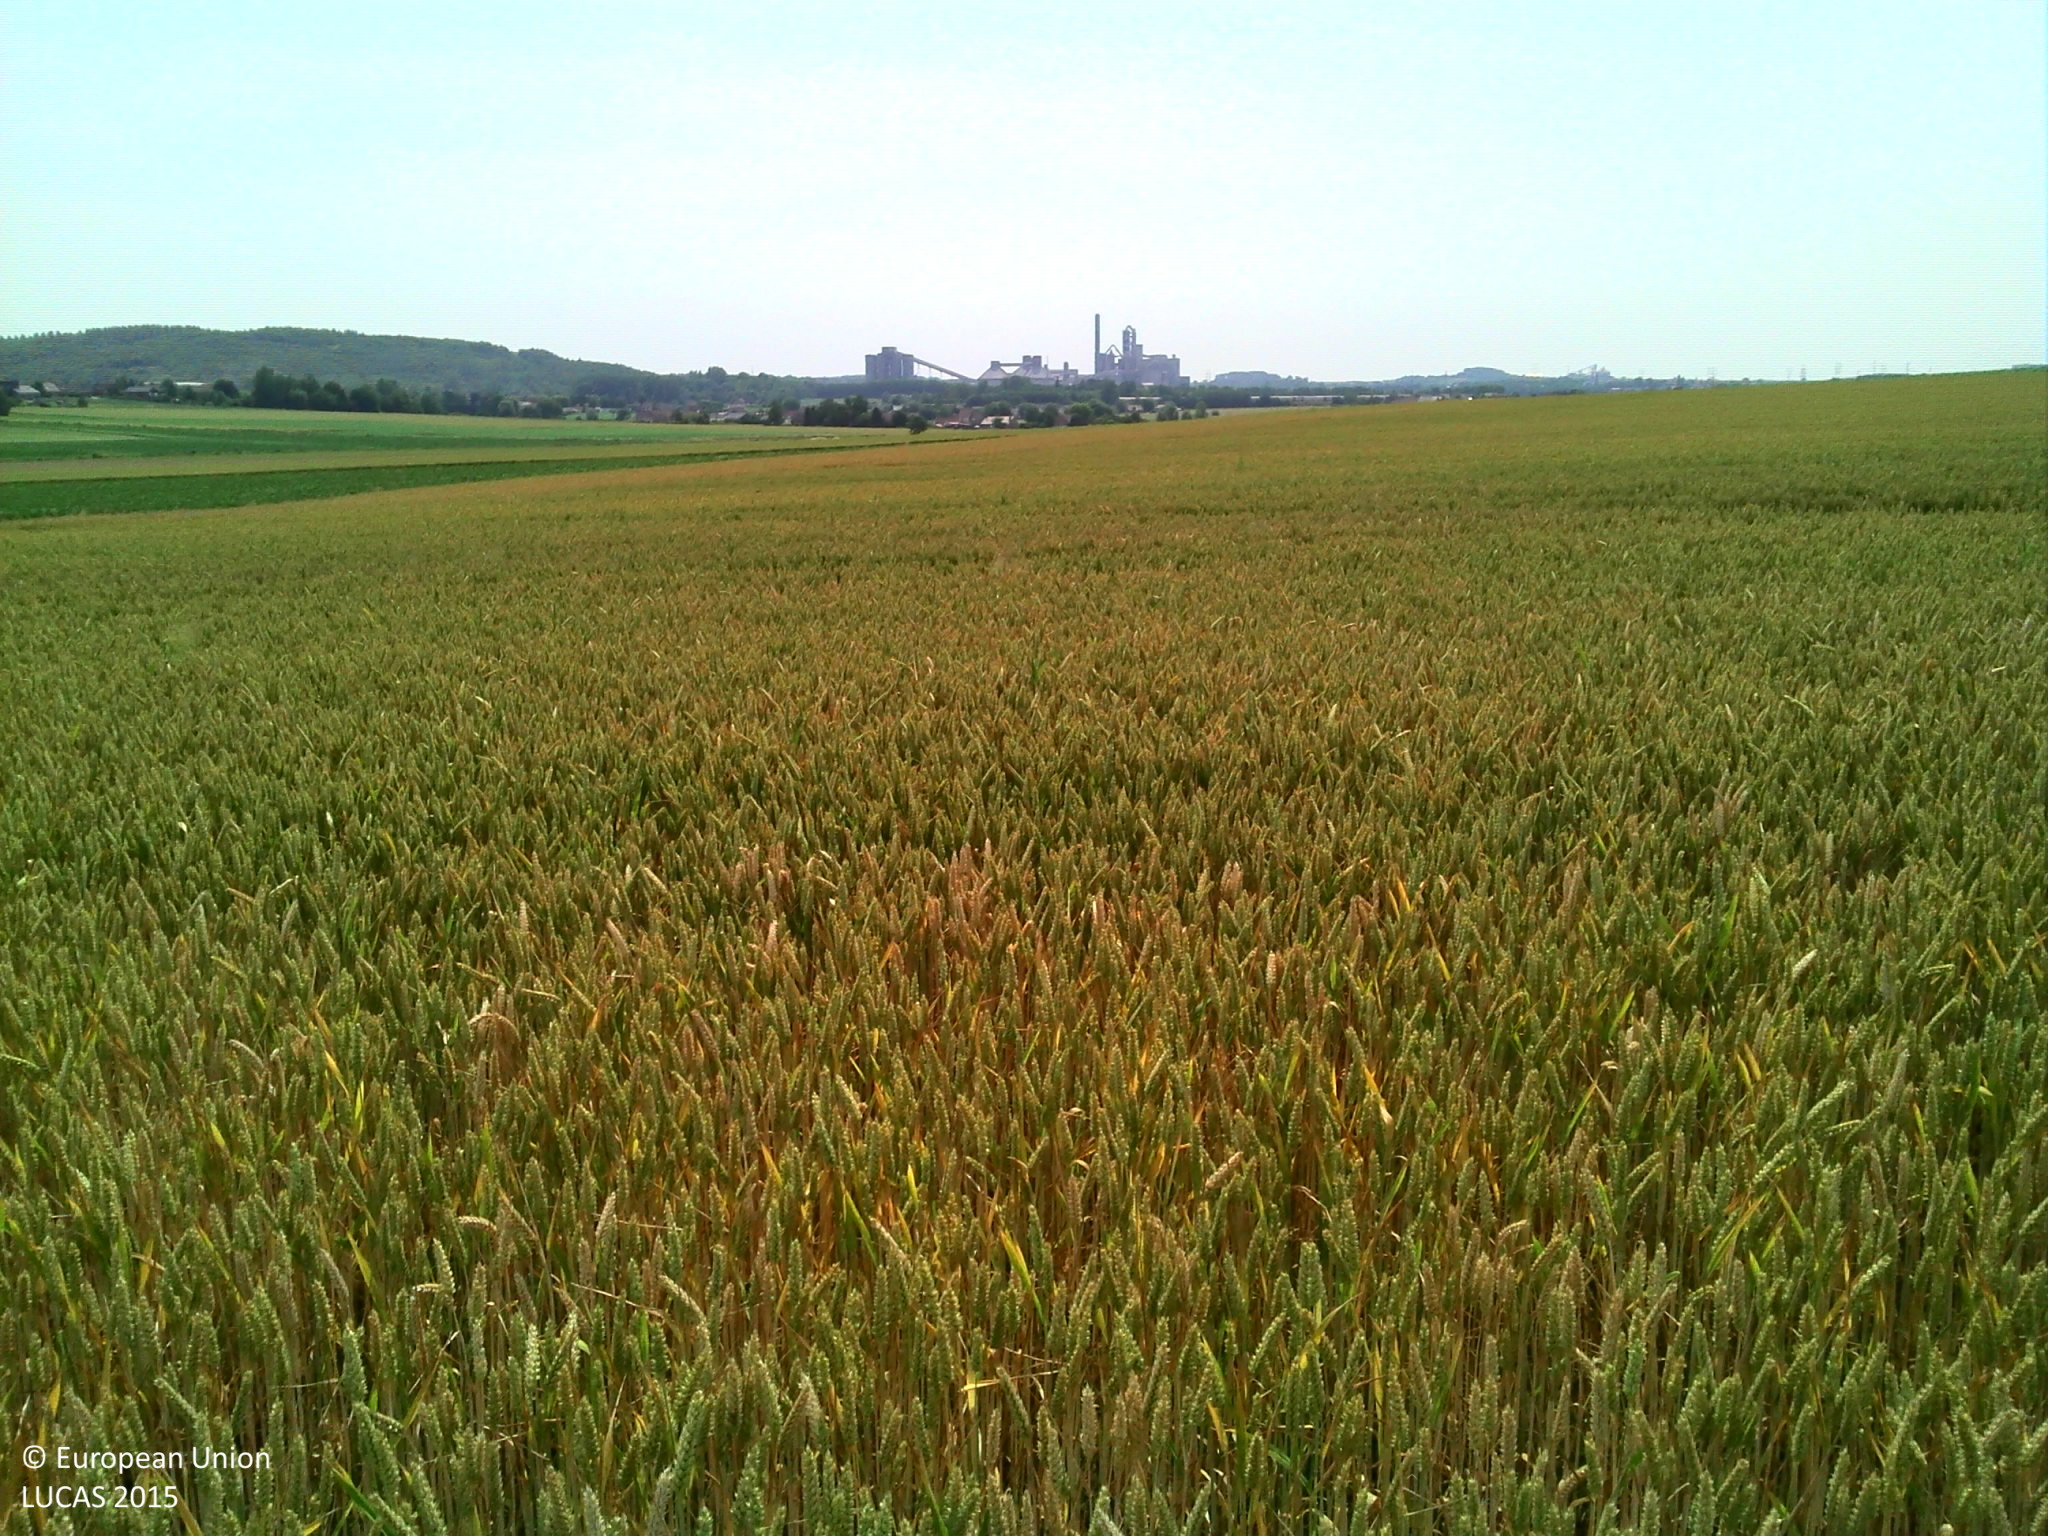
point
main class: Cropland
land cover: Common wheat
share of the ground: > 75 %
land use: Agriculture (excluding fallow land and kitchen gardens)
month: July
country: BE
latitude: 50.6287
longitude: 3.4750
